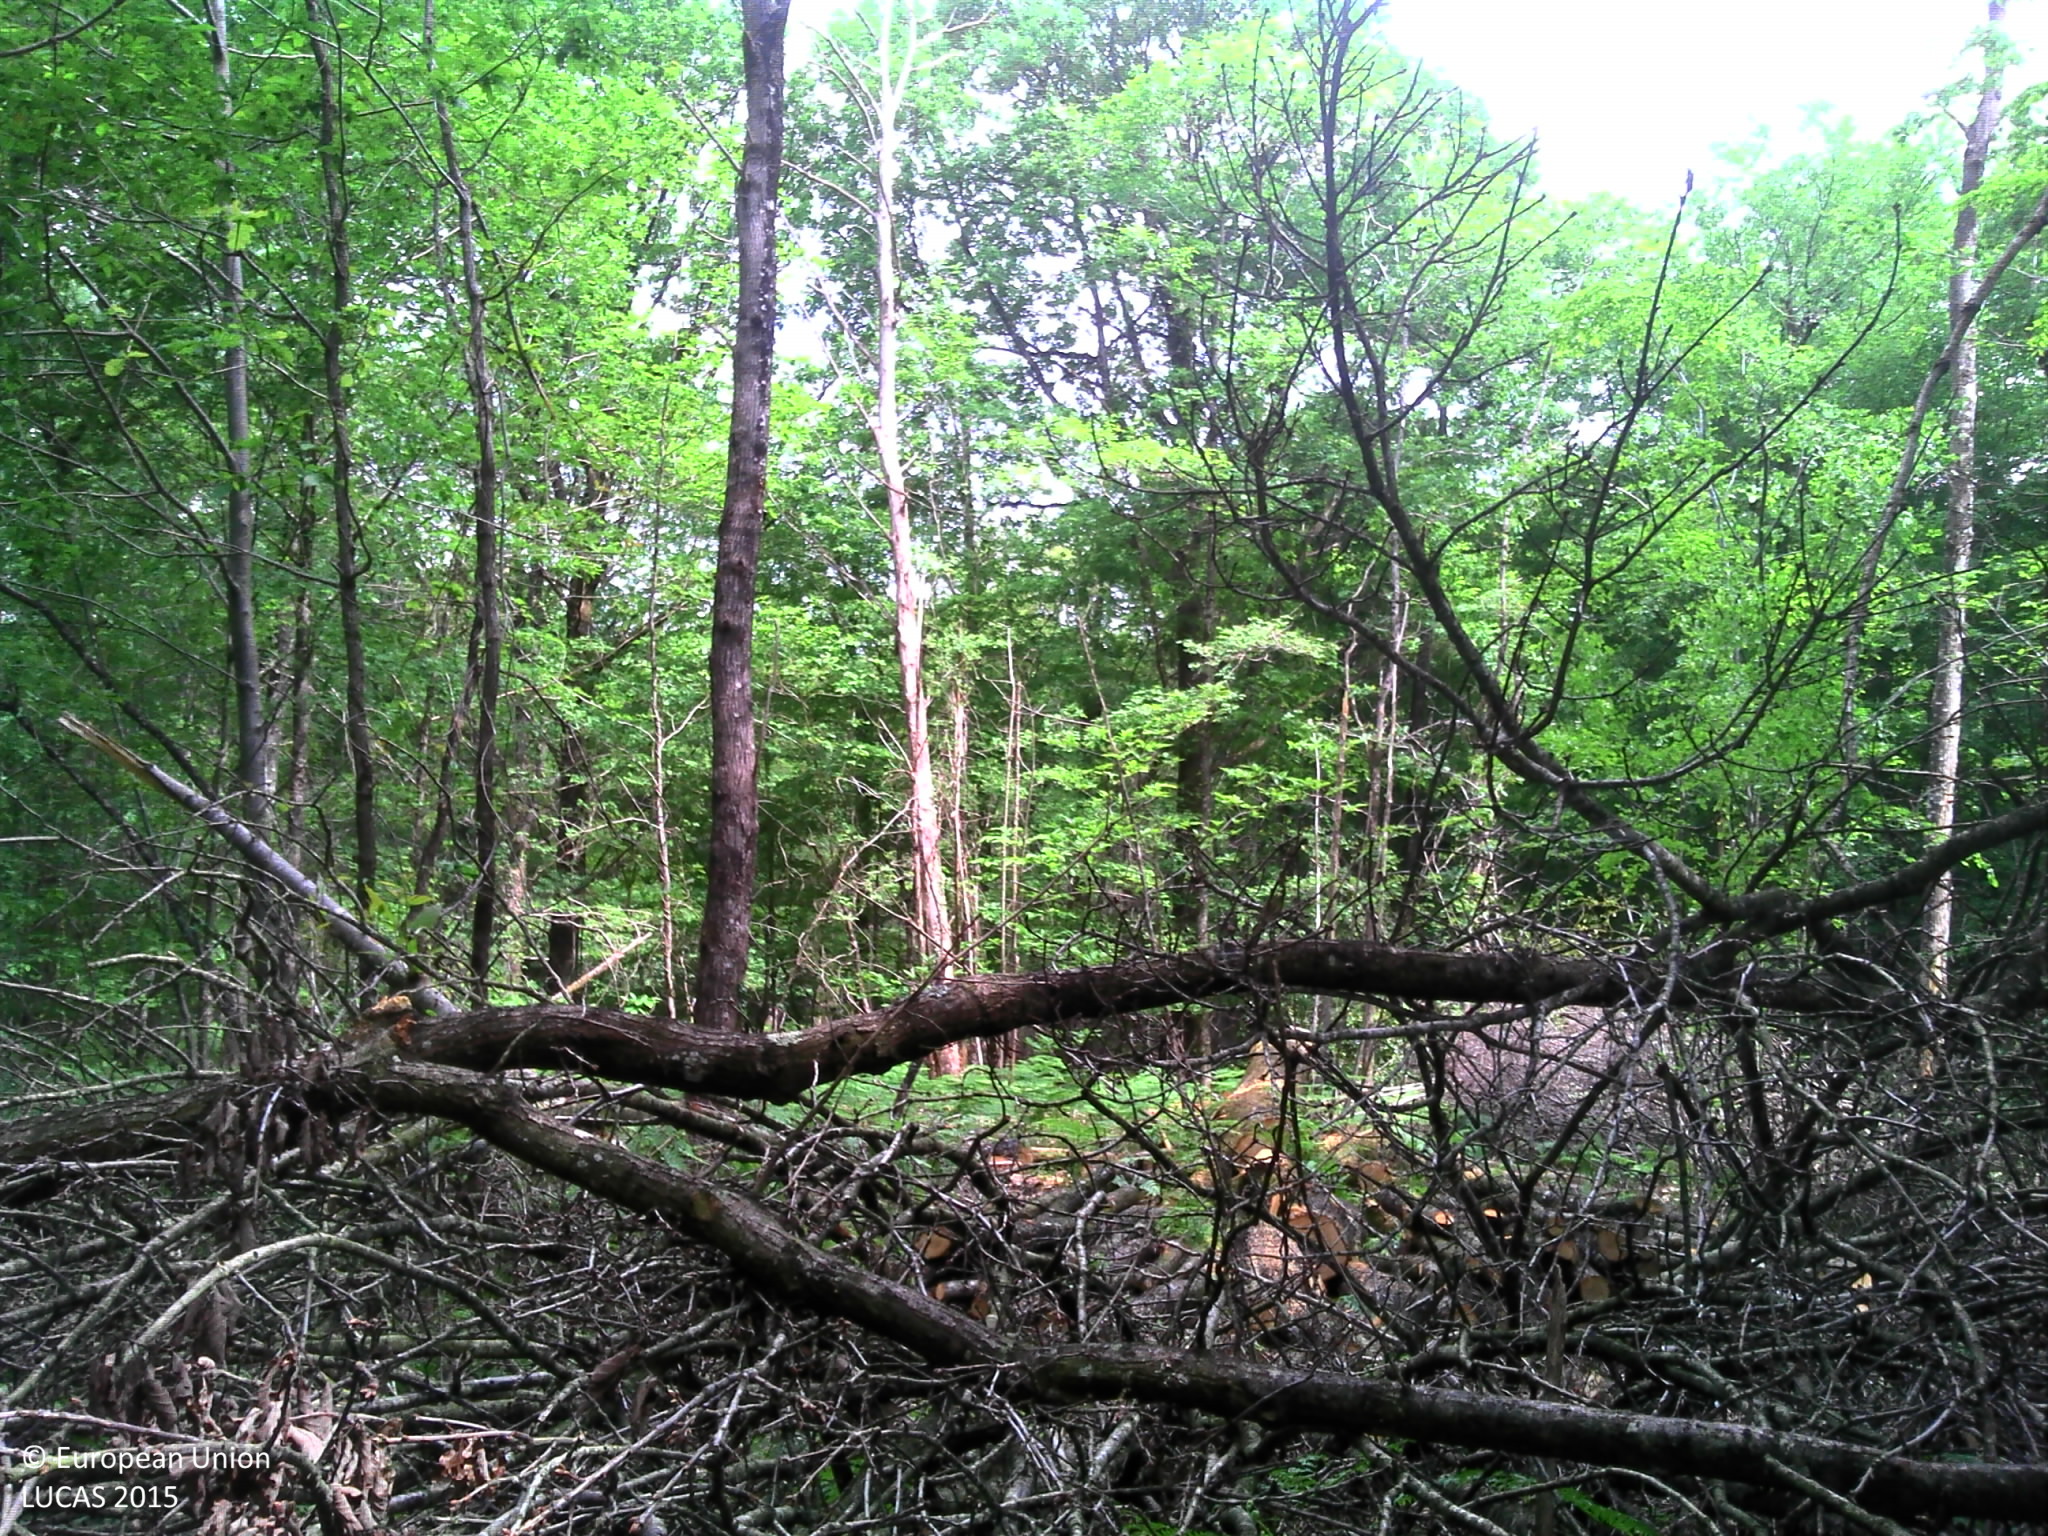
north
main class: Woodland
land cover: Broadleaved woodland
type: mesophytic deciduous forest
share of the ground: > 75 %
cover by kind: broadleaved forest trees 75 %, herbaceous plants 20 %, lichens and mosses 5 %
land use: Forestry
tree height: > 5 m
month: May
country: FR
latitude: 47.6888
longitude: 0.7471
